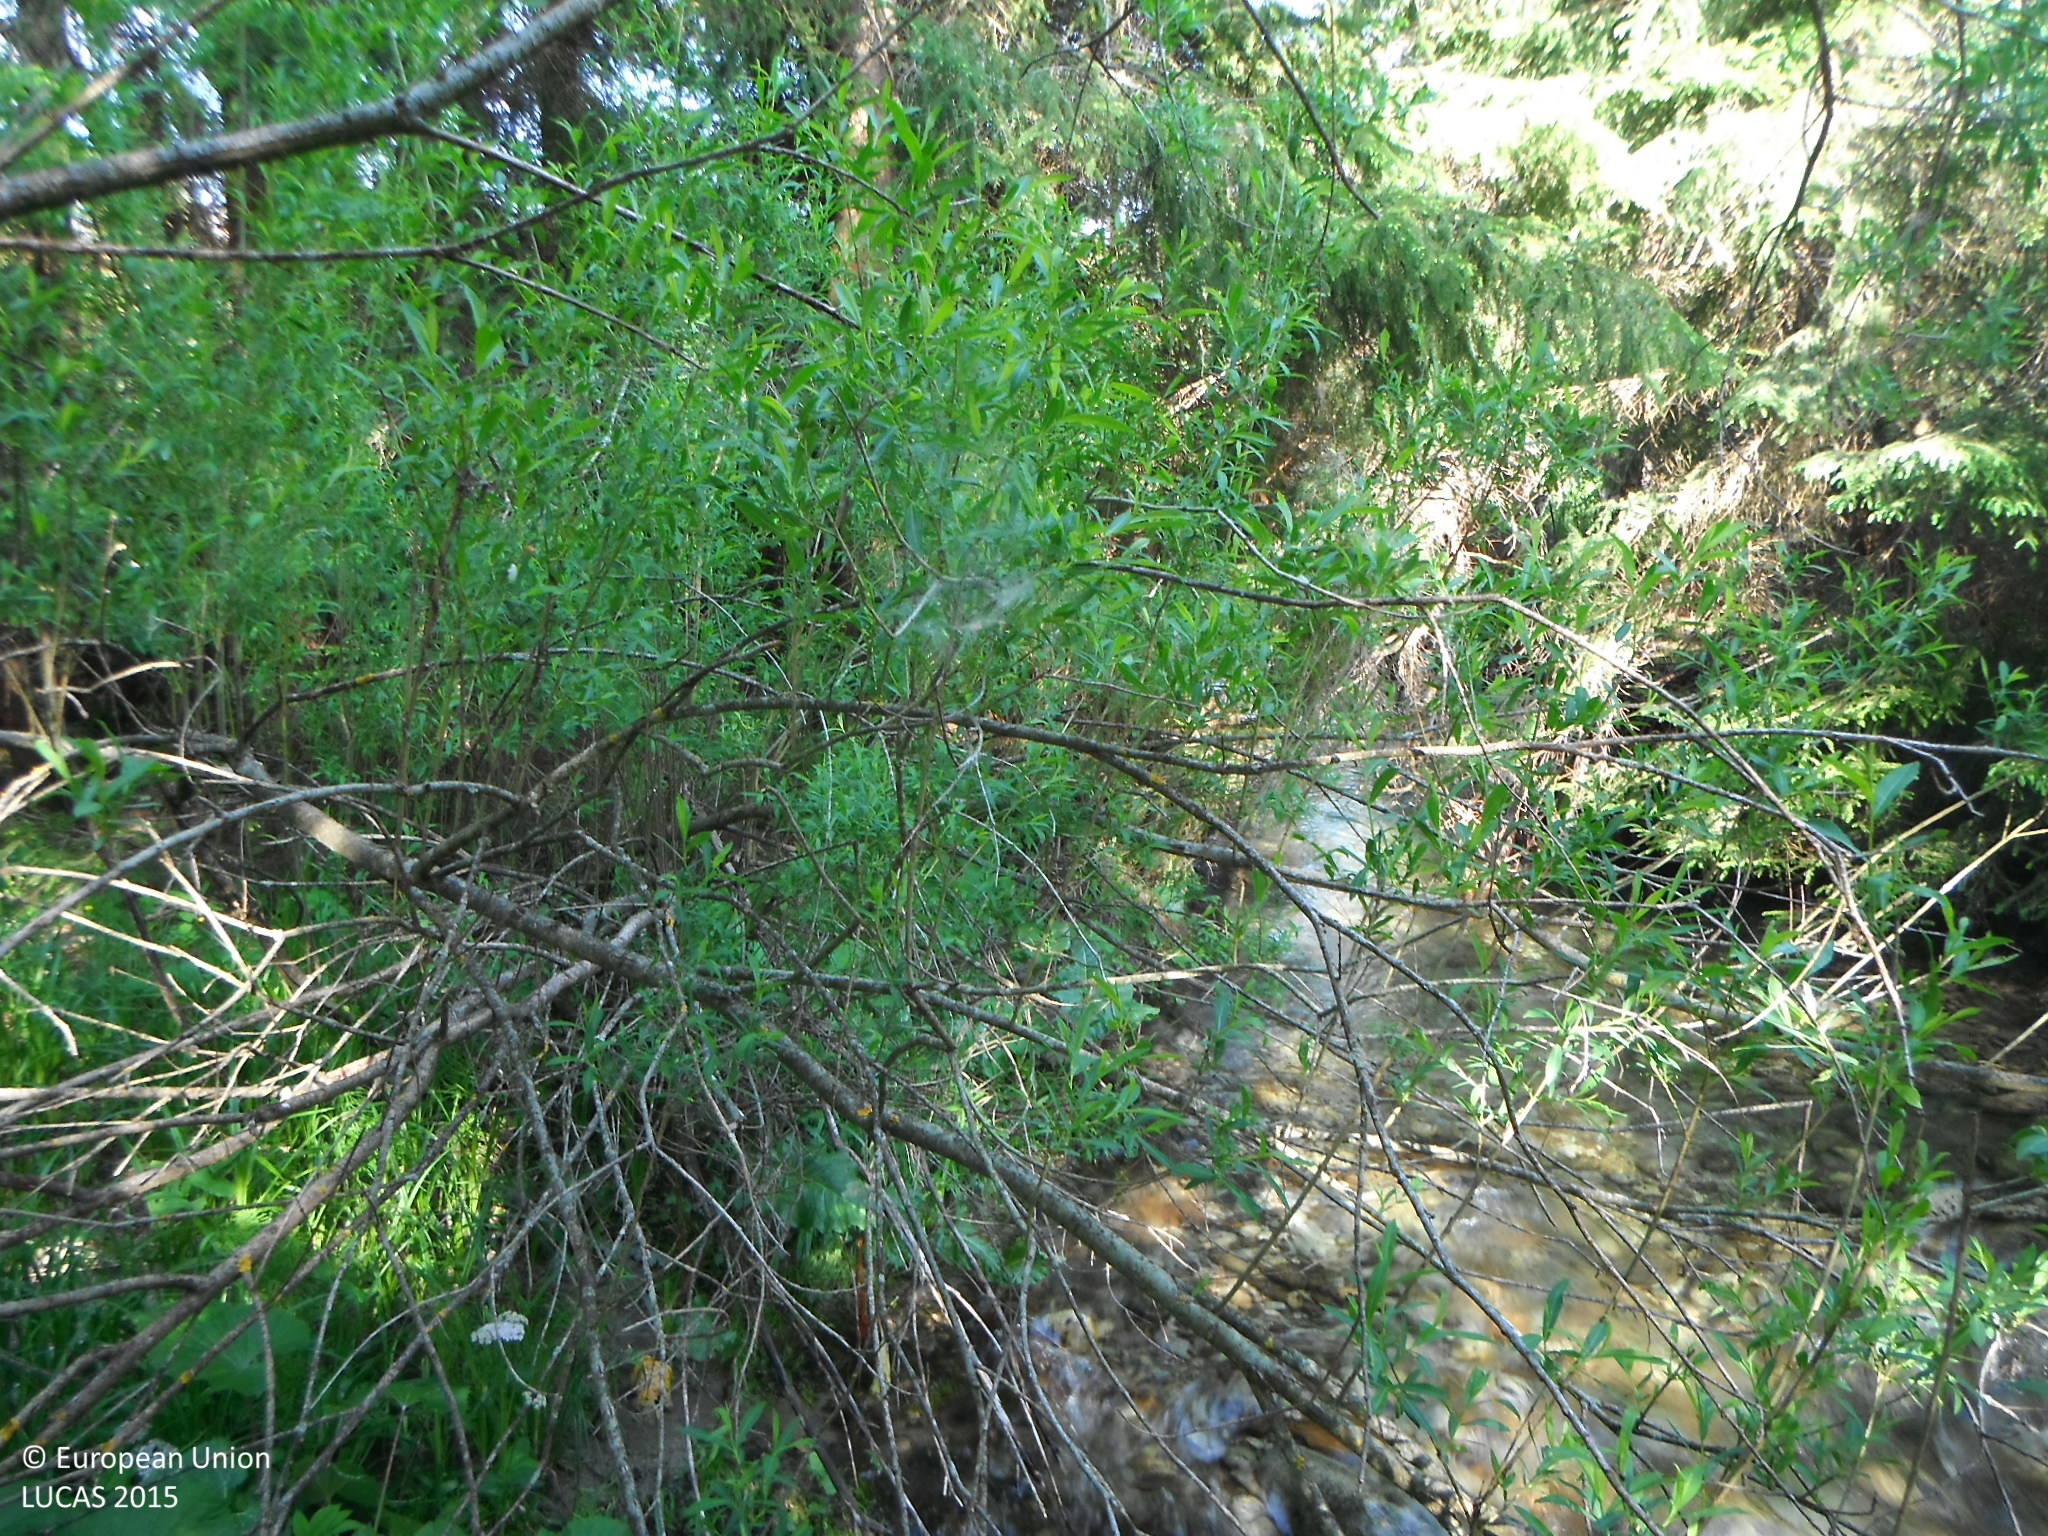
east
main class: Woodland
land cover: Broadleaved woodland
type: mesophytic deciduous forest
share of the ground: > 75 %
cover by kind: broadleaved forest trees 100 %
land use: Forestry
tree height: > 5 m
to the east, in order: Broadleaved woodland; Shrubland without tree cover; Inland fresh running water; Rocks and stones; Broadleaved woodland; Spruce dominated coniferous woodland
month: June
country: SK
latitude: 49.1068
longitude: 19.8234
